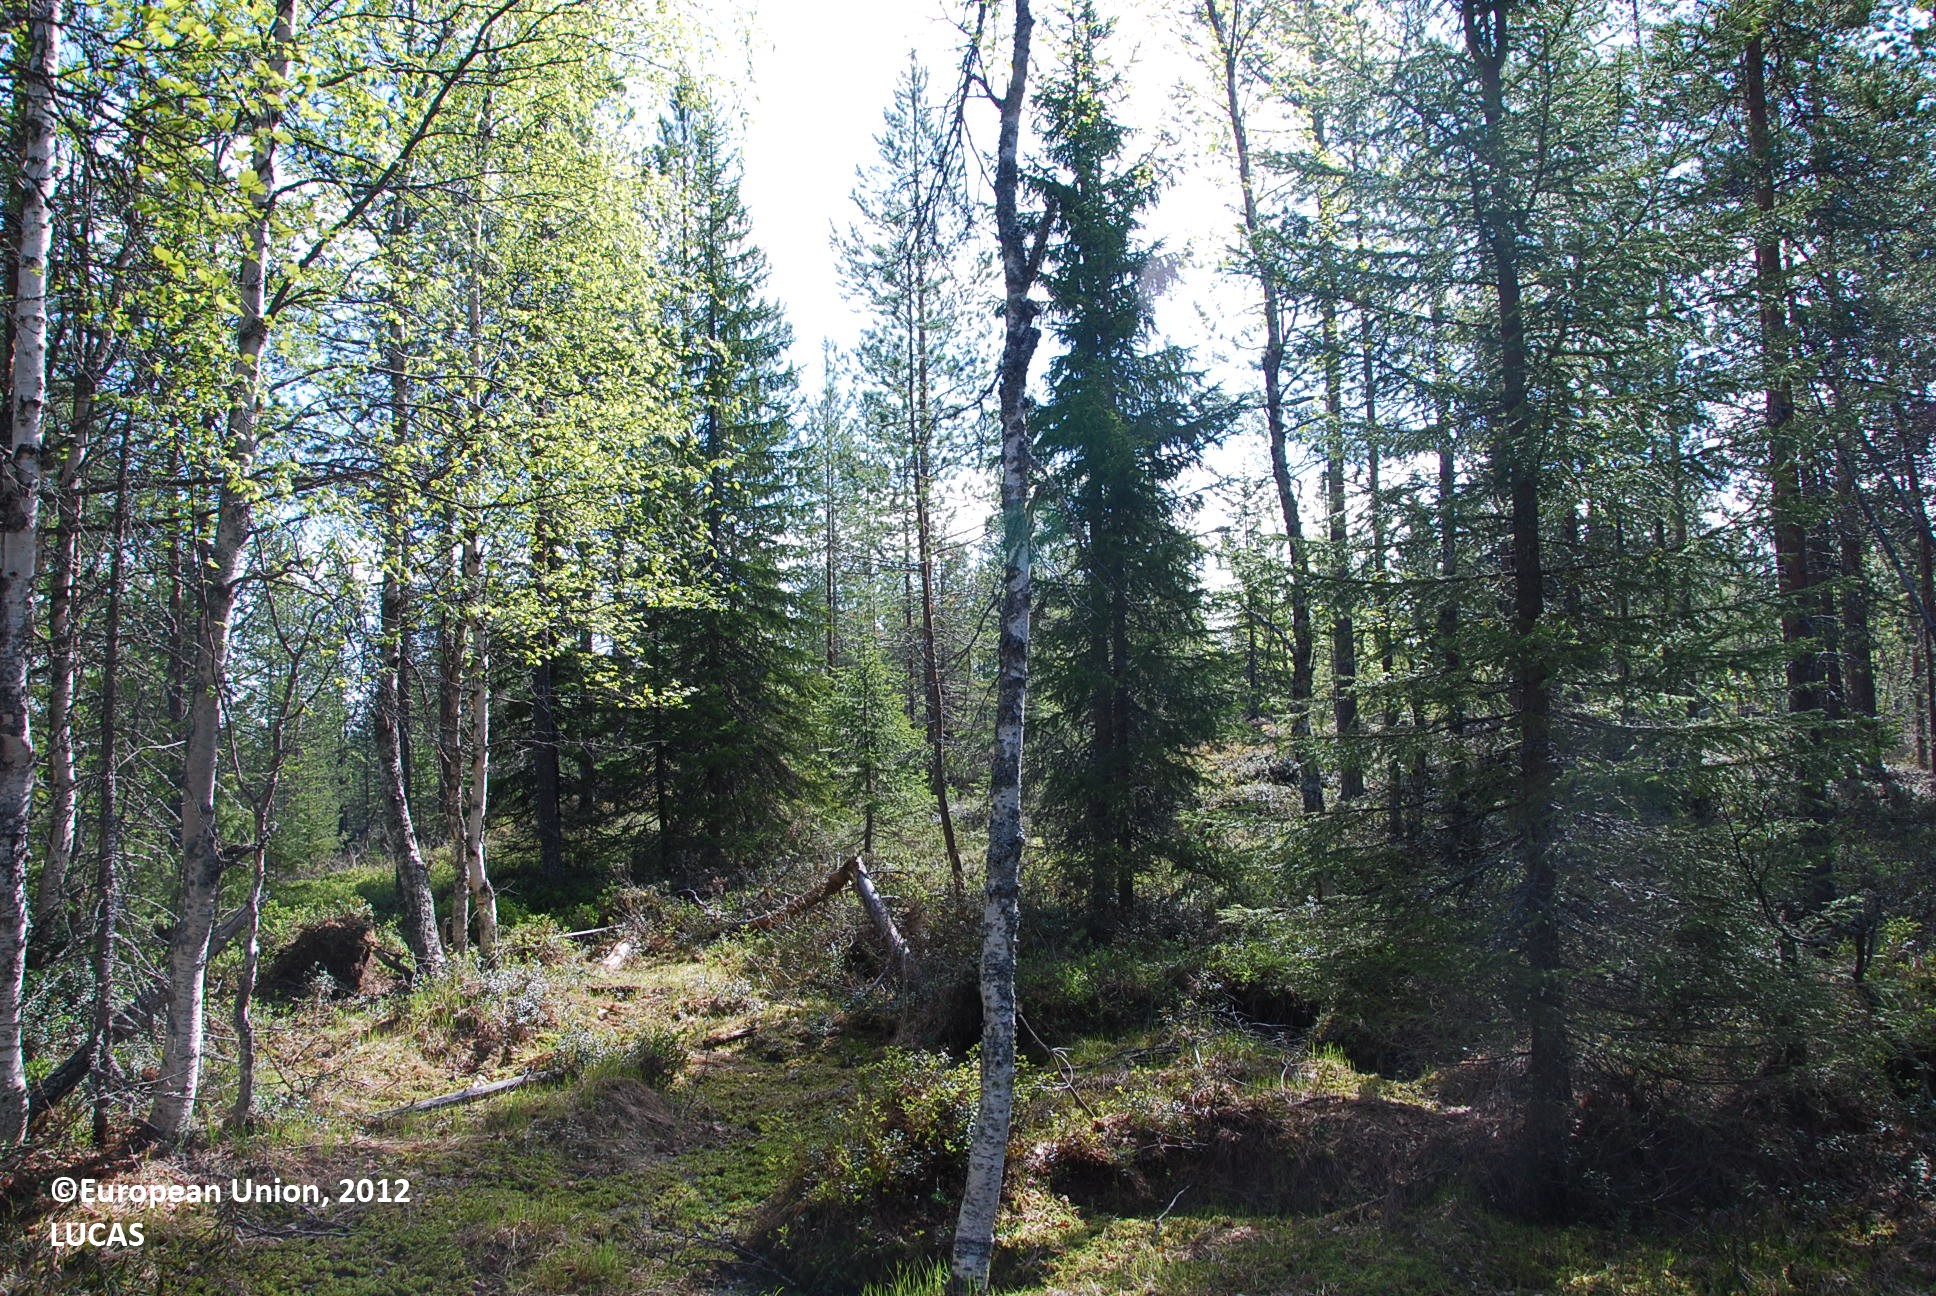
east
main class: Woodland
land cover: Other mixed woodland
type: boreal forest
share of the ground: > 75 %
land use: Forestry
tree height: > 5 m
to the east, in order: Other mixed woodland; Pine dominated coniferous woodland
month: June
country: FI
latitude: 66.3406
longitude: 27.8357
